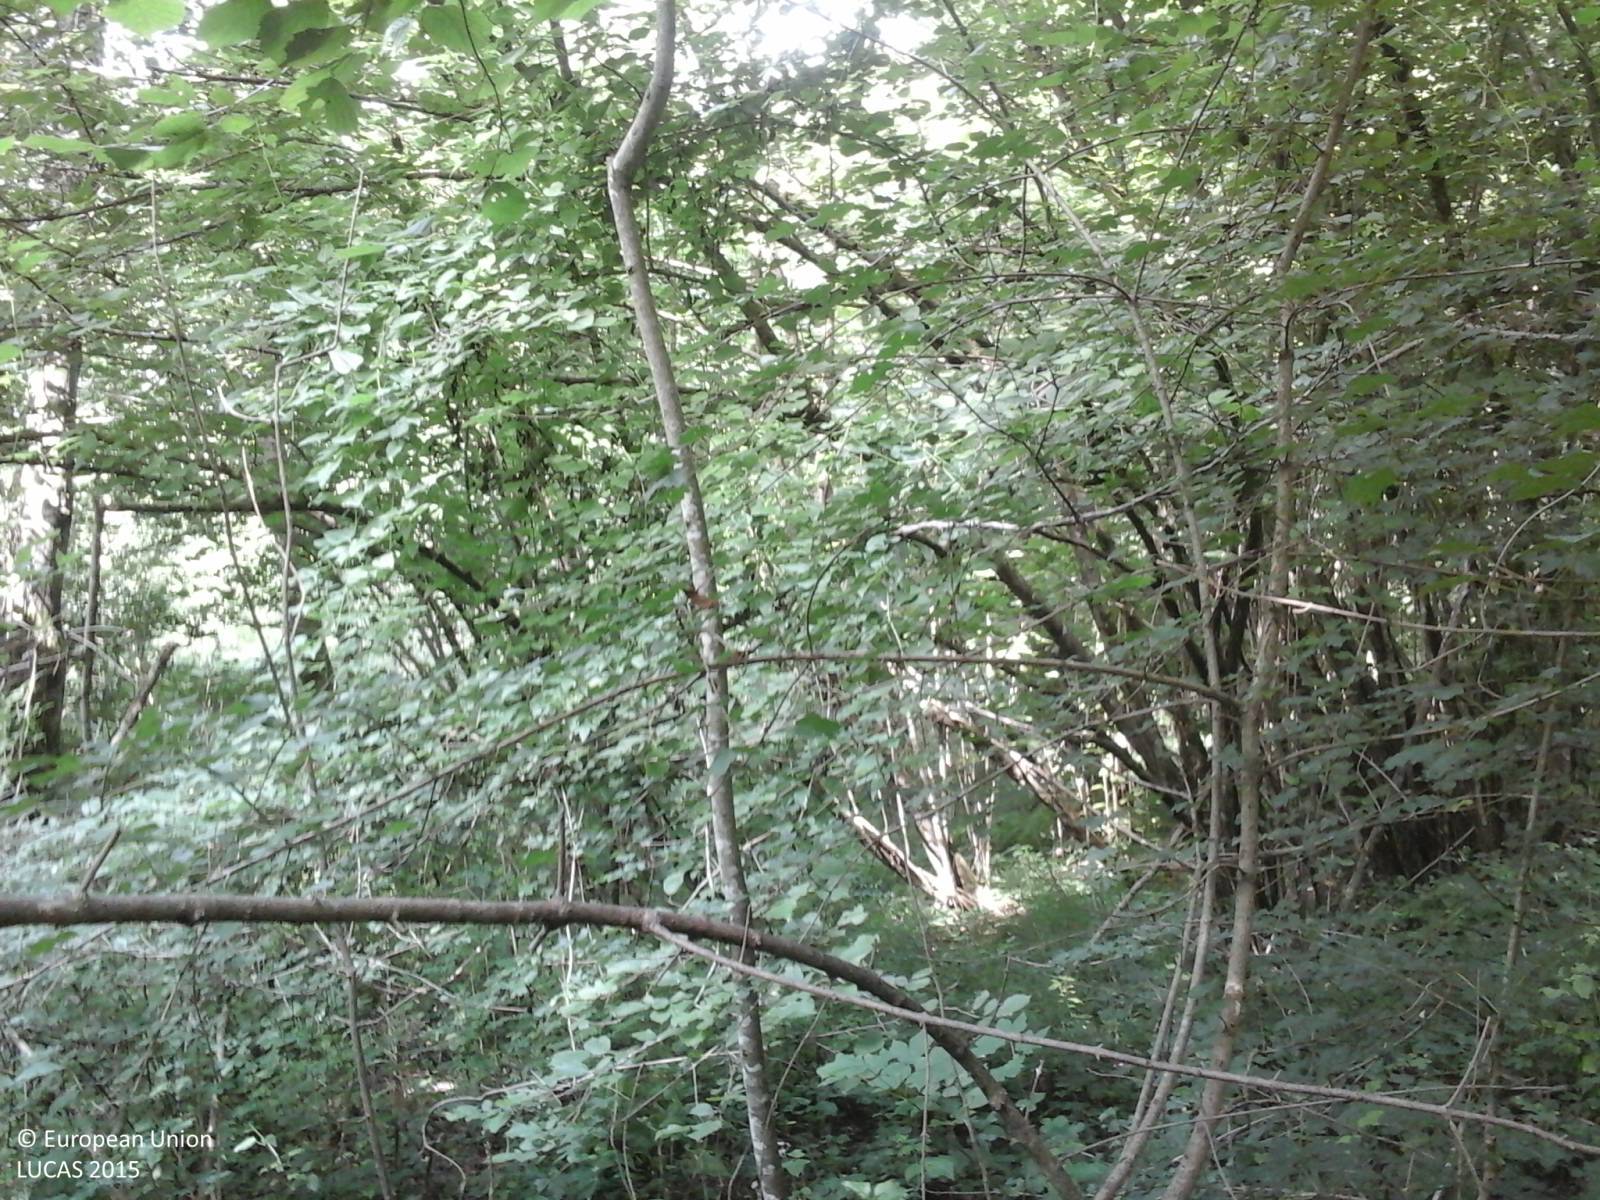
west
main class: Woodland
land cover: Broadleaved woodland
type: mesophytic deciduous forest
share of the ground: > 75 %
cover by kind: broadleaved forest trees 70 %, shrubs 20 %, herbaceous plants 10 %
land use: Forestry
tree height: > 5 m
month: July
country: IT
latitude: 46.1941
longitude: 12.5755
